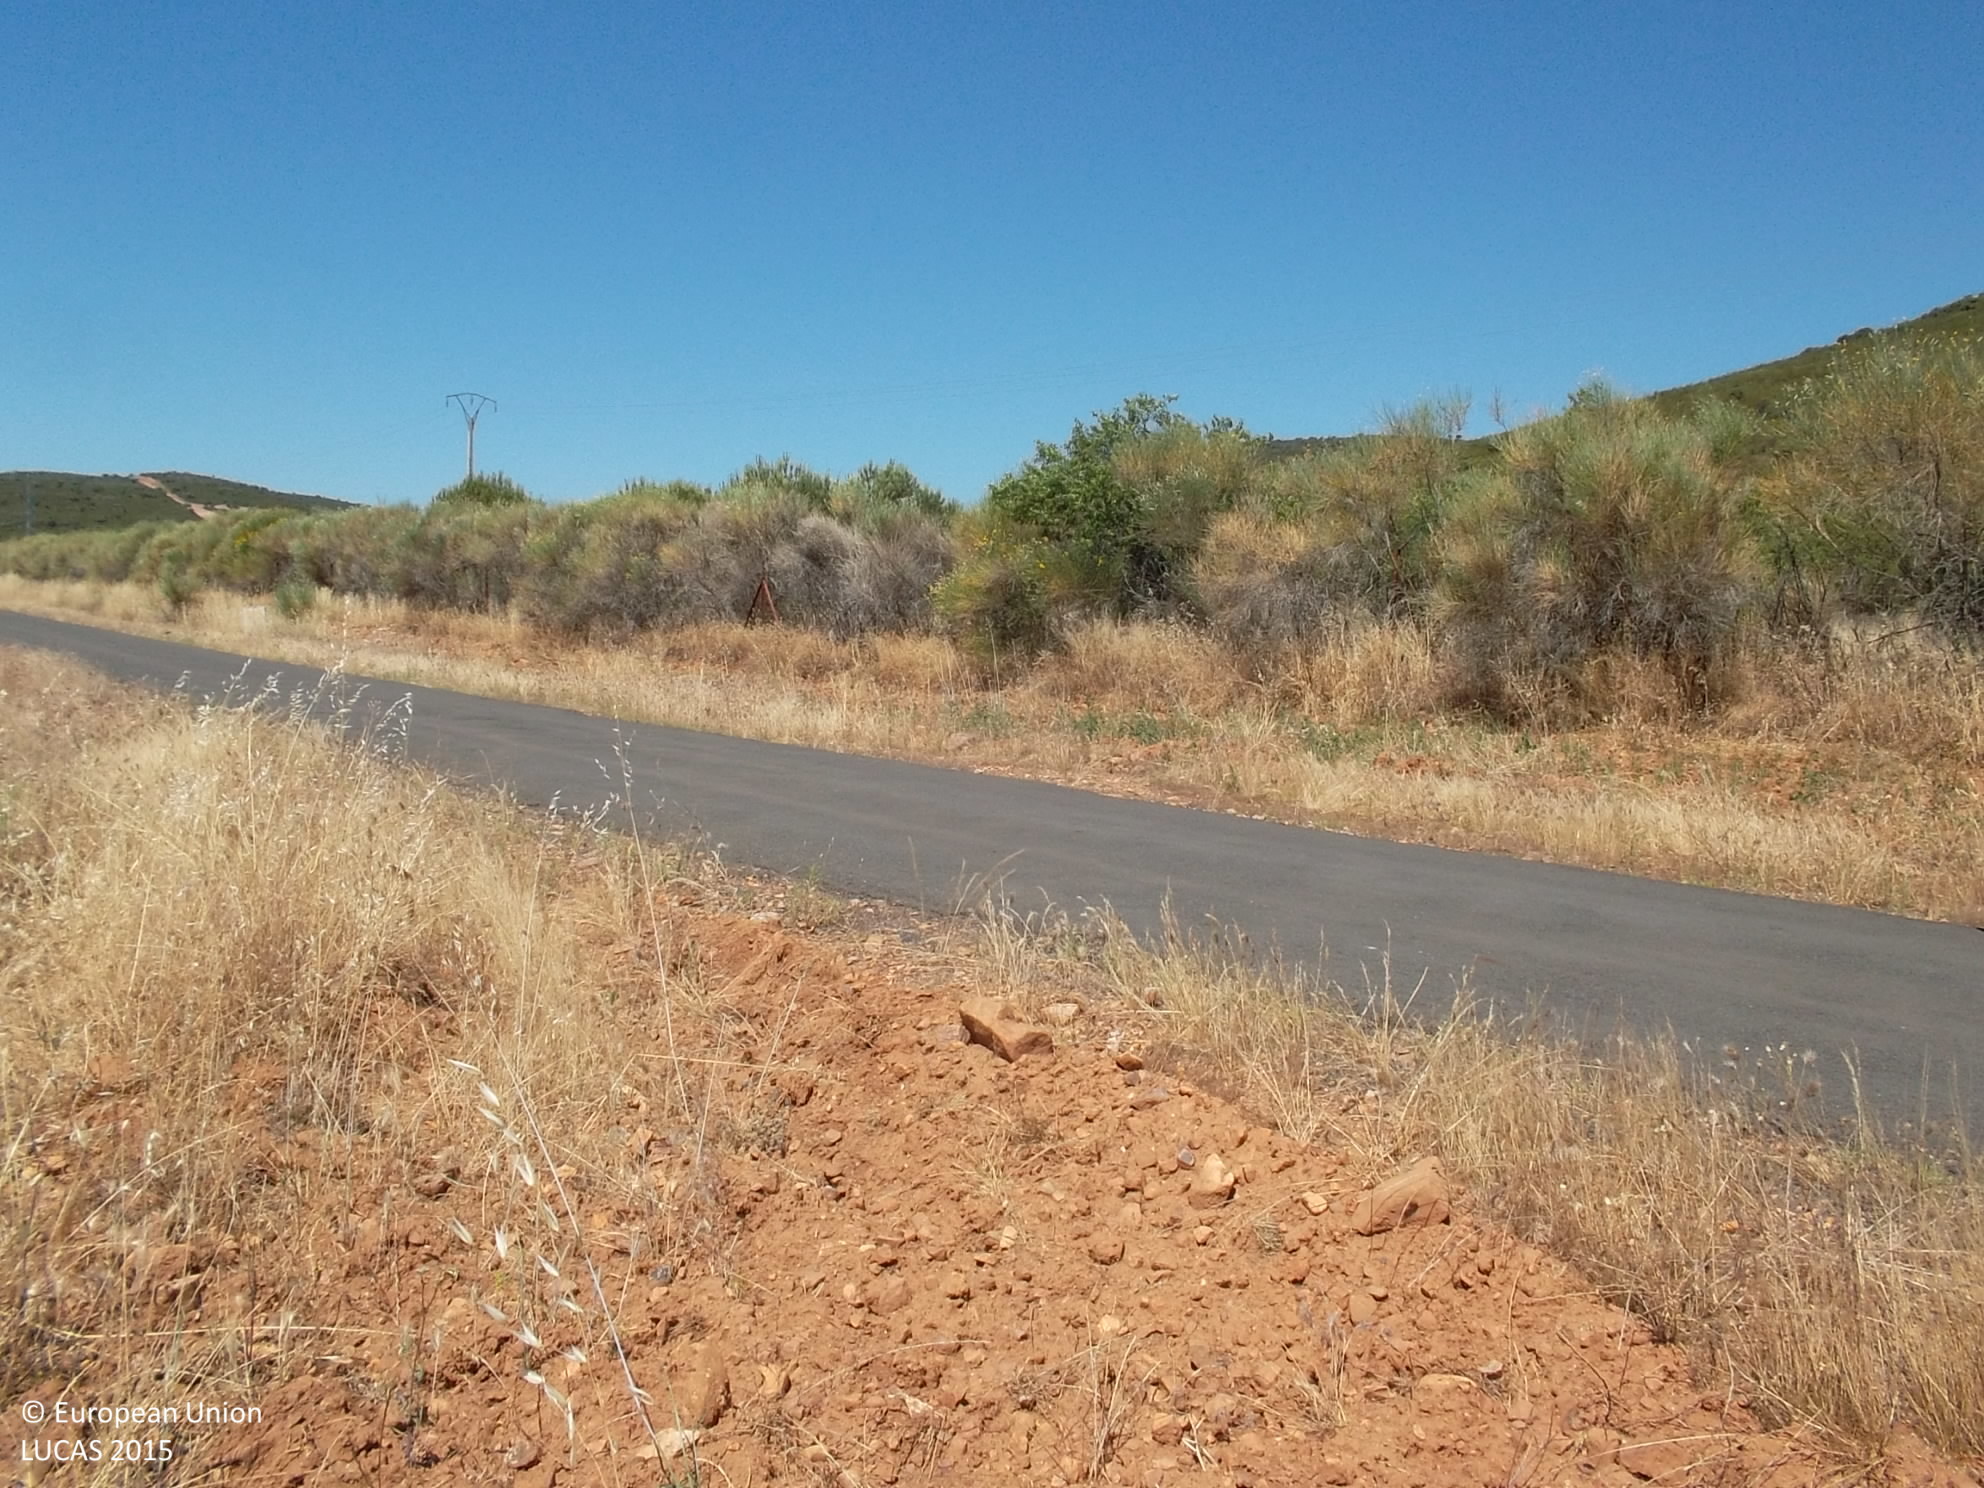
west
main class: Woodland
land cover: Broadleaved woodland
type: broadleaved evergreen forest
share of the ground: 10 - 25 %
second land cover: Spontaneously vegetated surfaces
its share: > 75 %
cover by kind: herbaceous plants 60 %, broadleaved forest trees 20 %, shrubs 20 %
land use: Forestry
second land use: Agriculture (excluding fallow land and kitchen gardens)
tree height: > 5 m
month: June
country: ES
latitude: 39.1250
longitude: -4.0316
